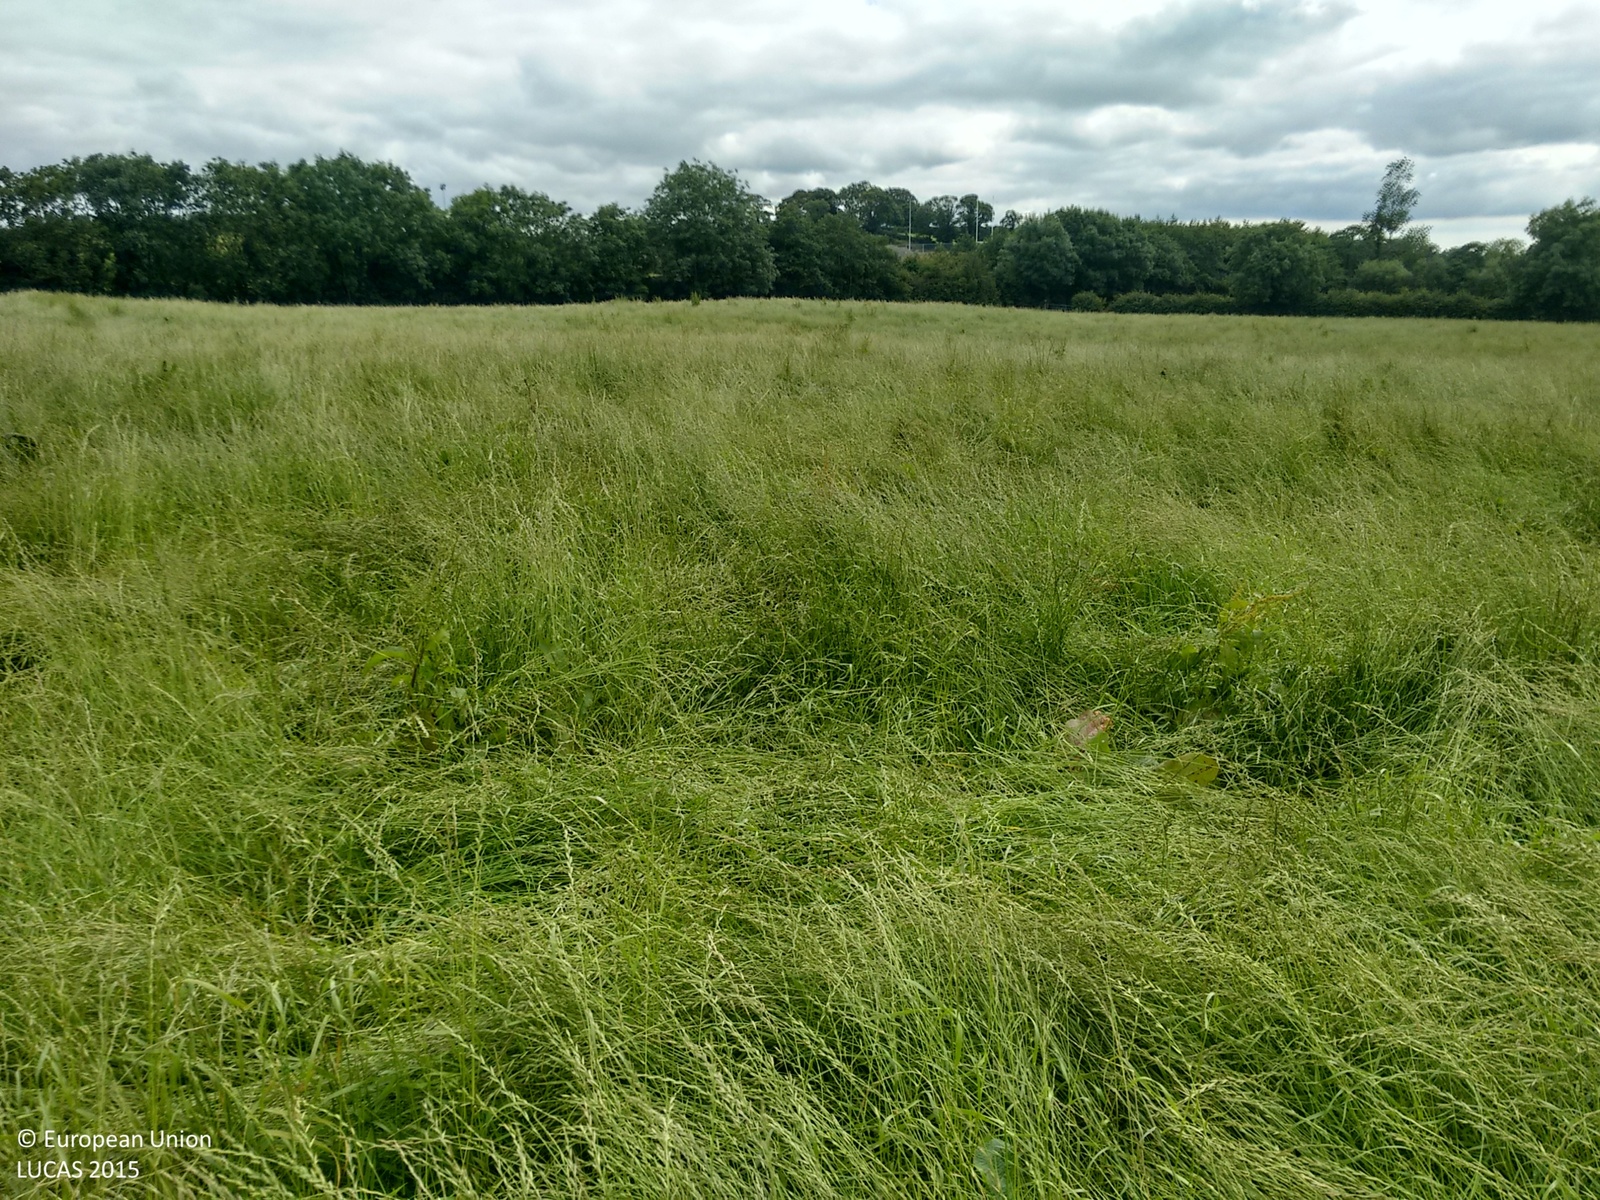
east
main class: Grassland
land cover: Grassland without tree/shrub cover
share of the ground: > 75 %
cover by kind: herbaceous plants 100 %
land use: Agriculture (excluding fallow land and kitchen gardens)
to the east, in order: Grassland without tree/shrub cover; Fences; Abandoned hedges; Ditches and canals; Grassland without tree/shrub cover; Abandoned hedges; Fences; Artificial constructions in urban areas
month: August
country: GB
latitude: 54.0585
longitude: -6.6443
